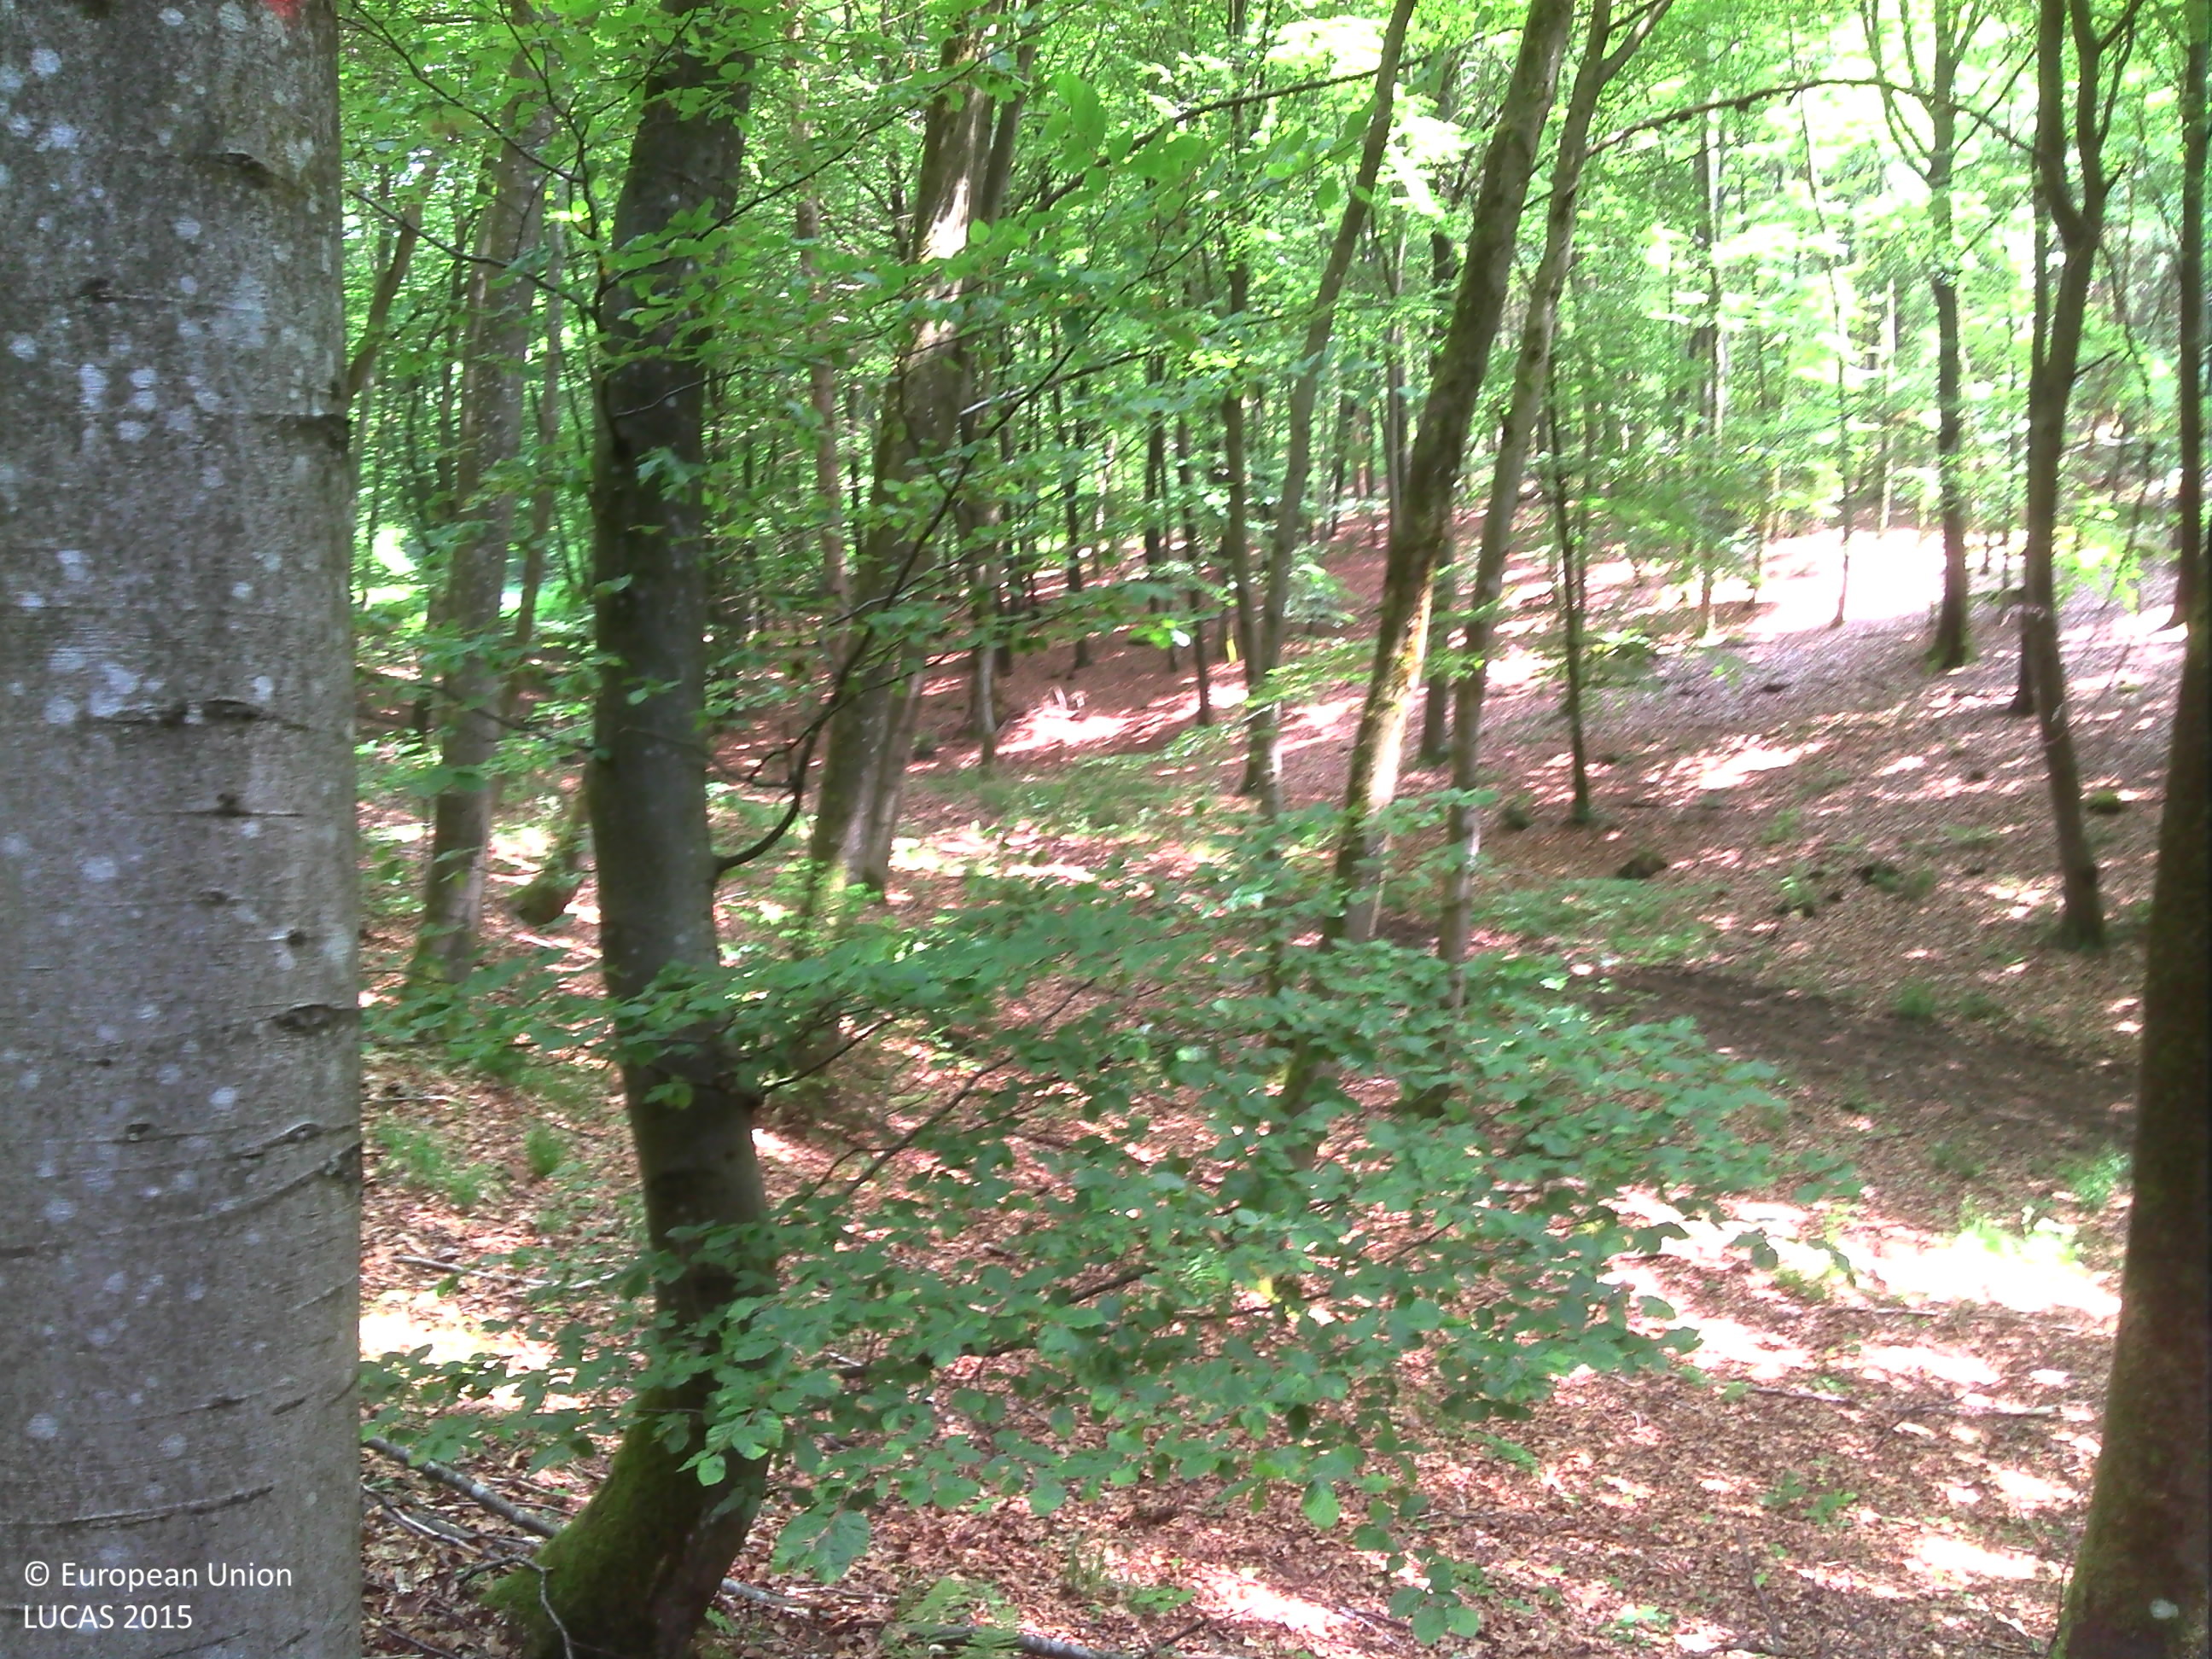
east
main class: Woodland
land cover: Broadleaved woodland
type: beech forest
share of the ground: > 75 %
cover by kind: broadleaved forest trees 100 %
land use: Forestry
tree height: > 5 m
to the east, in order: Broadleaved woodland; Spruce dominated mixed woodland; Tracks; Spruce dominated mixed woodland; Spruce dominated coniferous woodland; Tracks; Spruce dominated coniferous woodland
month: June
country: BE
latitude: 50.3924
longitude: 6.2436
